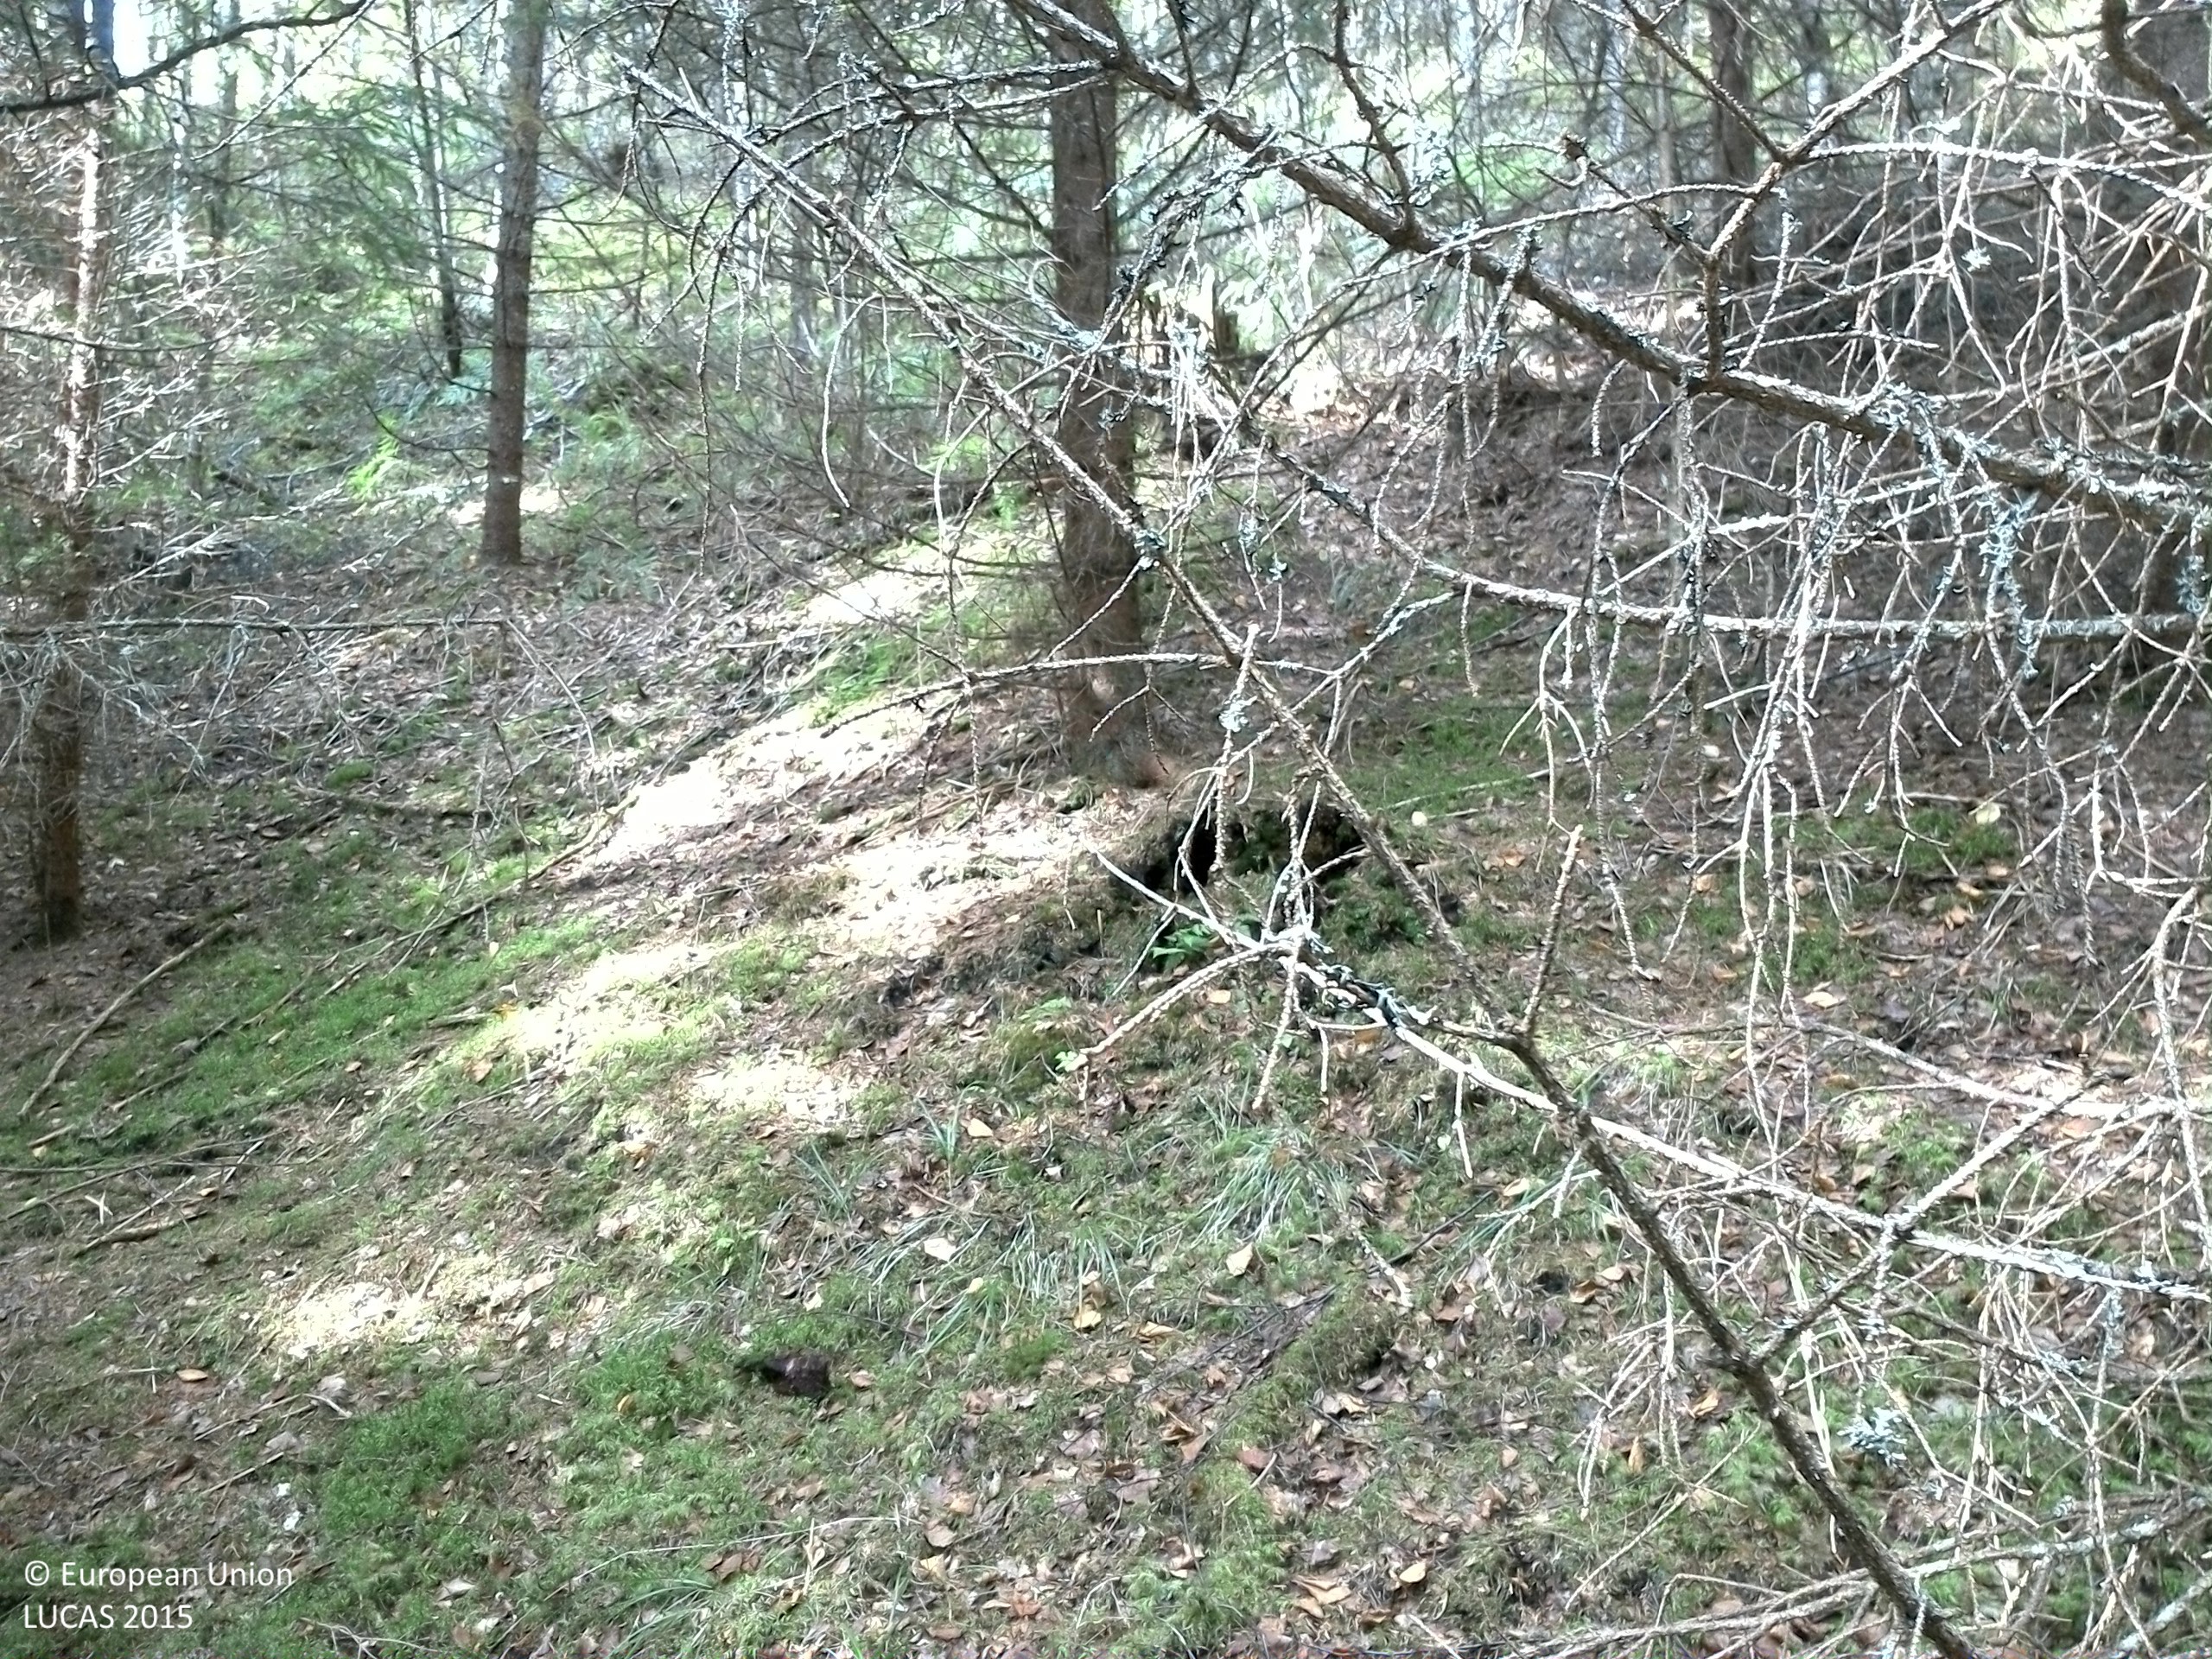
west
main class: Woodland
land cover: Spruce dominated coniferous woodland
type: boreal forest
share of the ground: 50 - 75 %
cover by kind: coniferous forest trees 60 %, lichens and mosses 20 %, broadleaved forest trees 10 %, shrubs 5 %, herbaceous plants 5 %
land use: Forestry
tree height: > 5 m
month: September
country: SE
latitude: 59.9566
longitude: 13.5185
